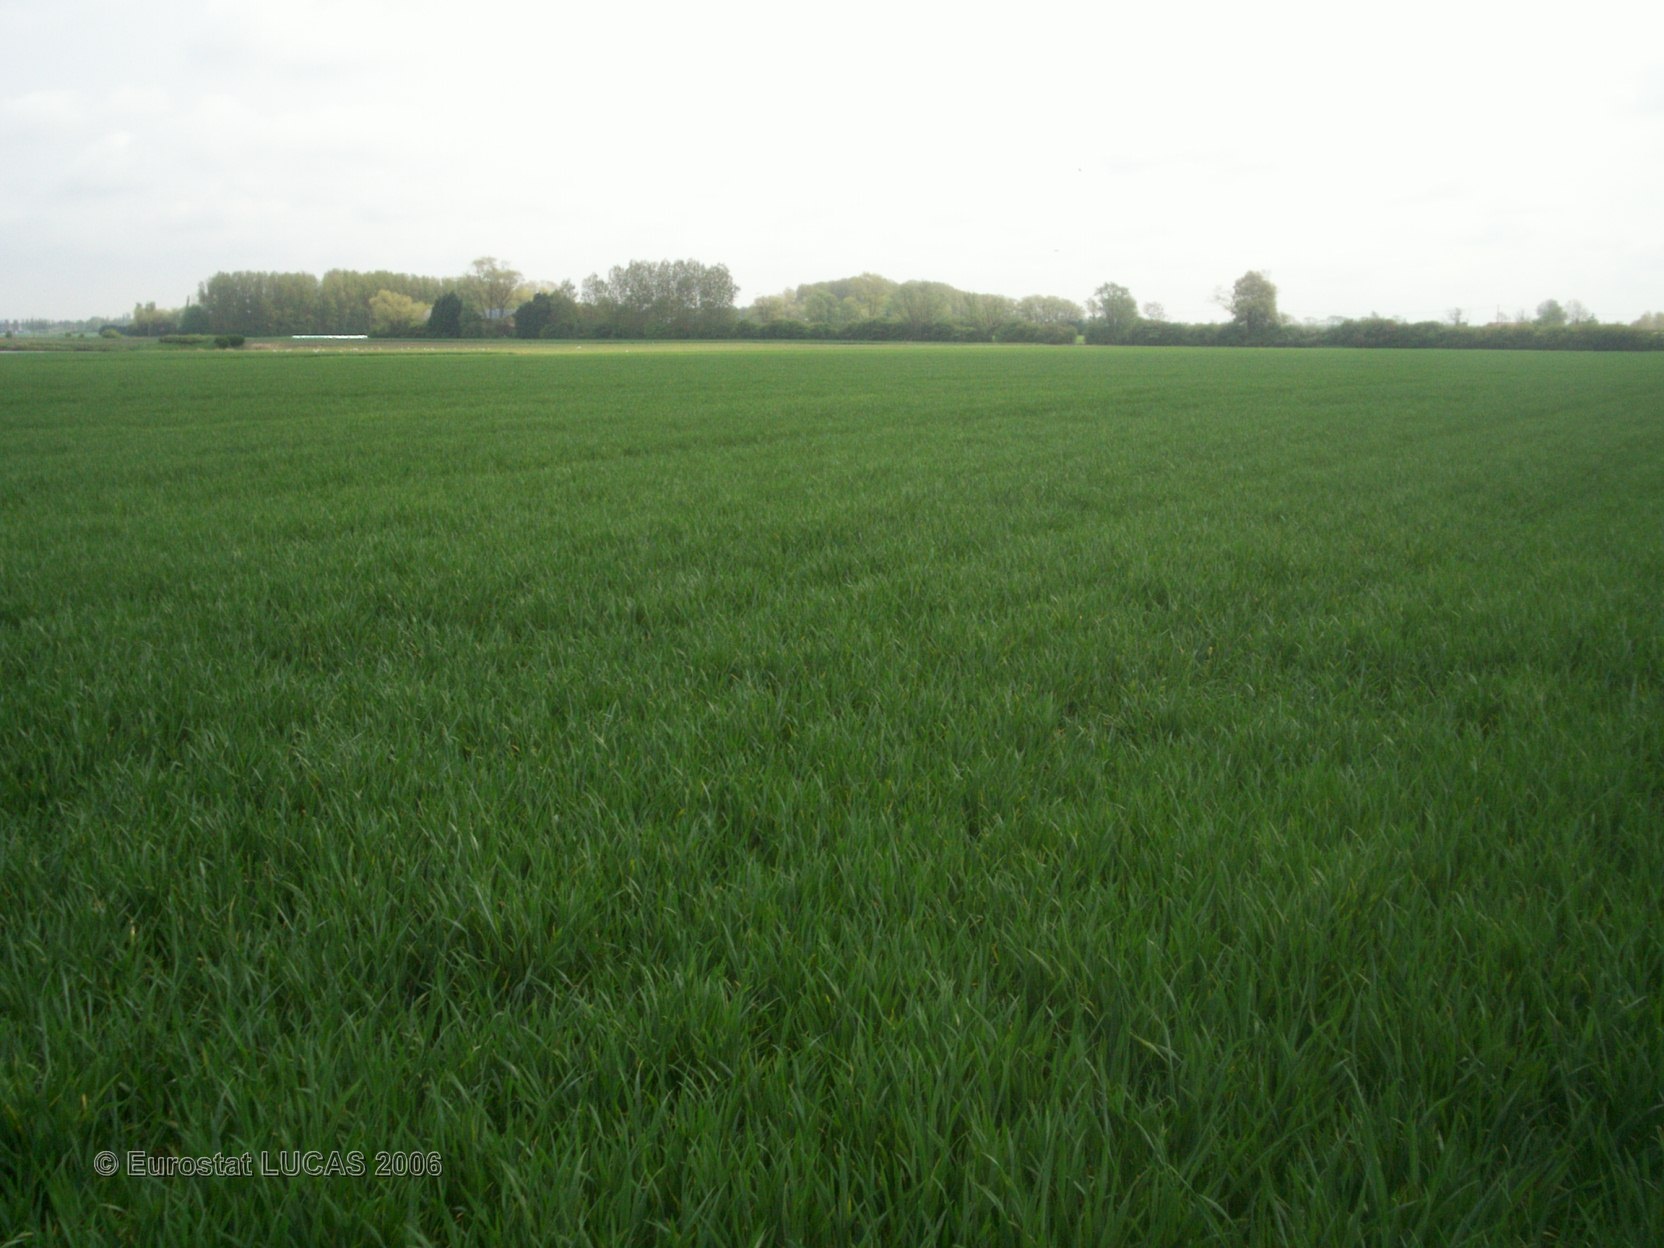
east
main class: Cropland
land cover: Common wheat
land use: Agriculture (excluding fallow land and kitchen gardens)
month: May
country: FR
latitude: 50.9165
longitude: 2.2907
